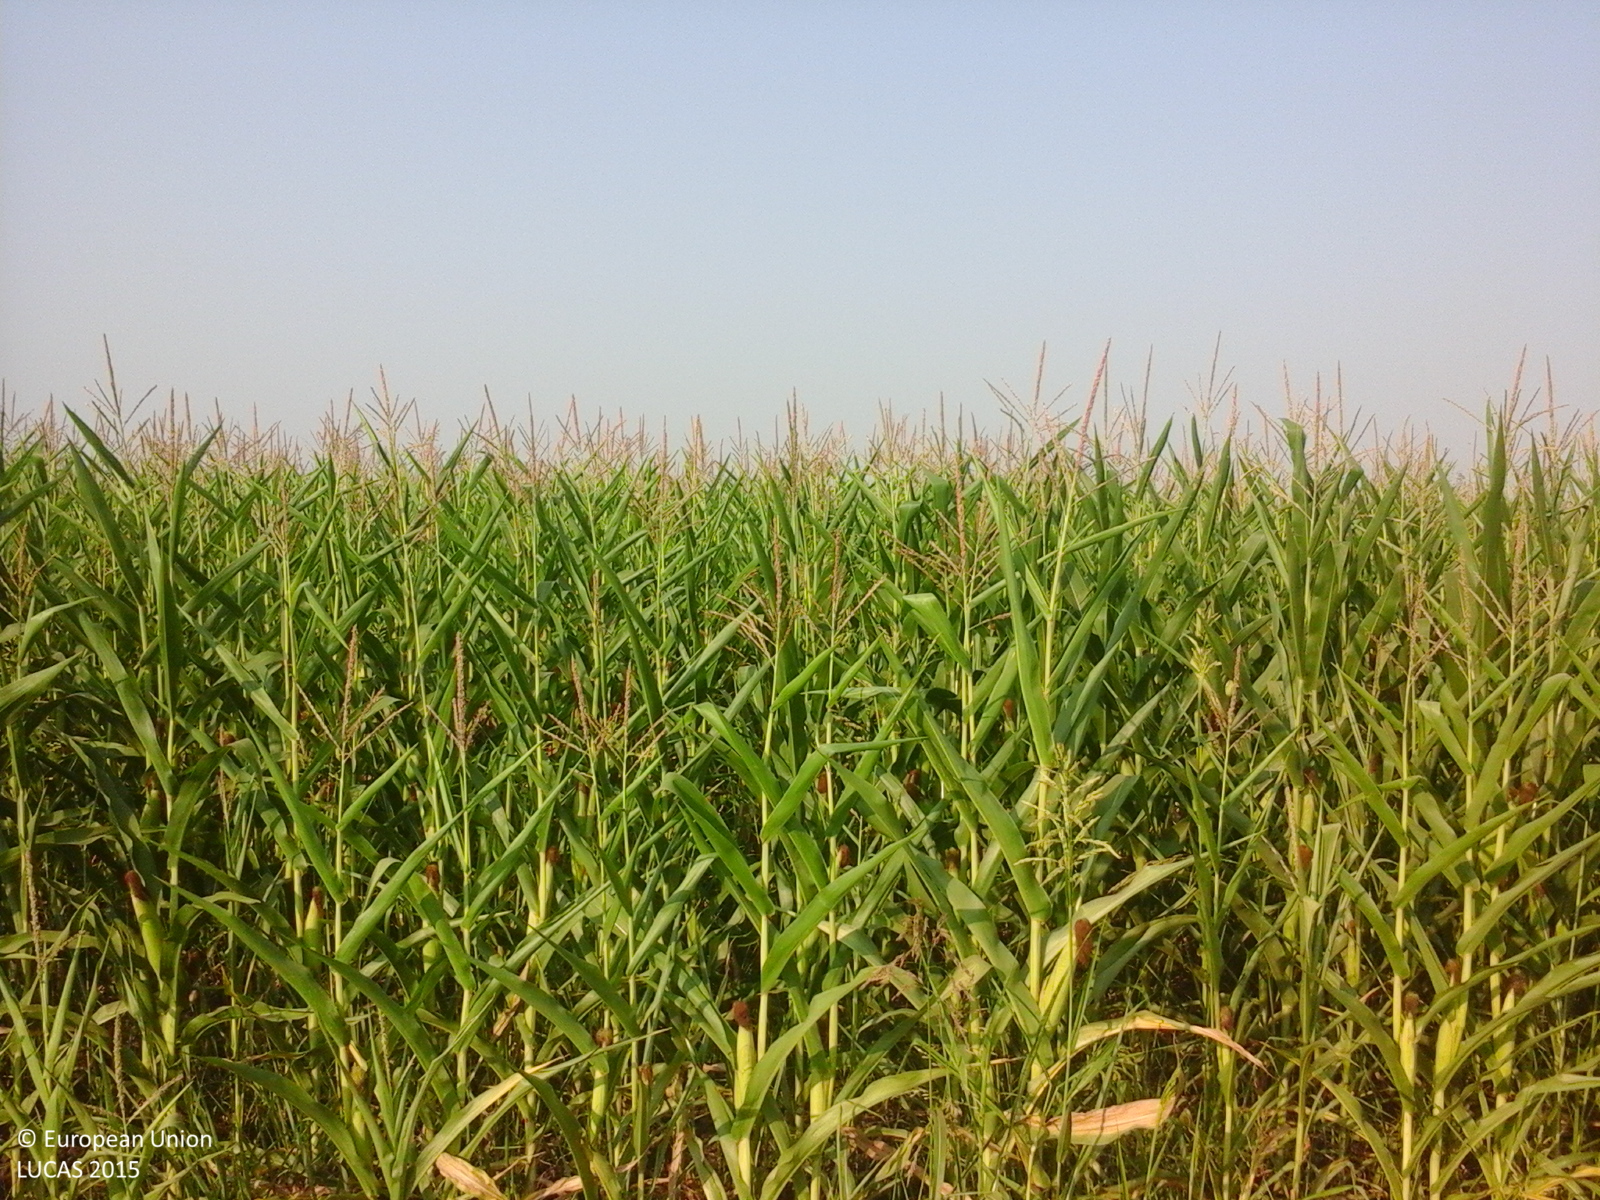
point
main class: Cropland
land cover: Maize
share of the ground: > 75 %
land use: Agriculture (excluding fallow land and kitchen gardens)
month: July
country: RO
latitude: 44.4945
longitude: 26.5794
